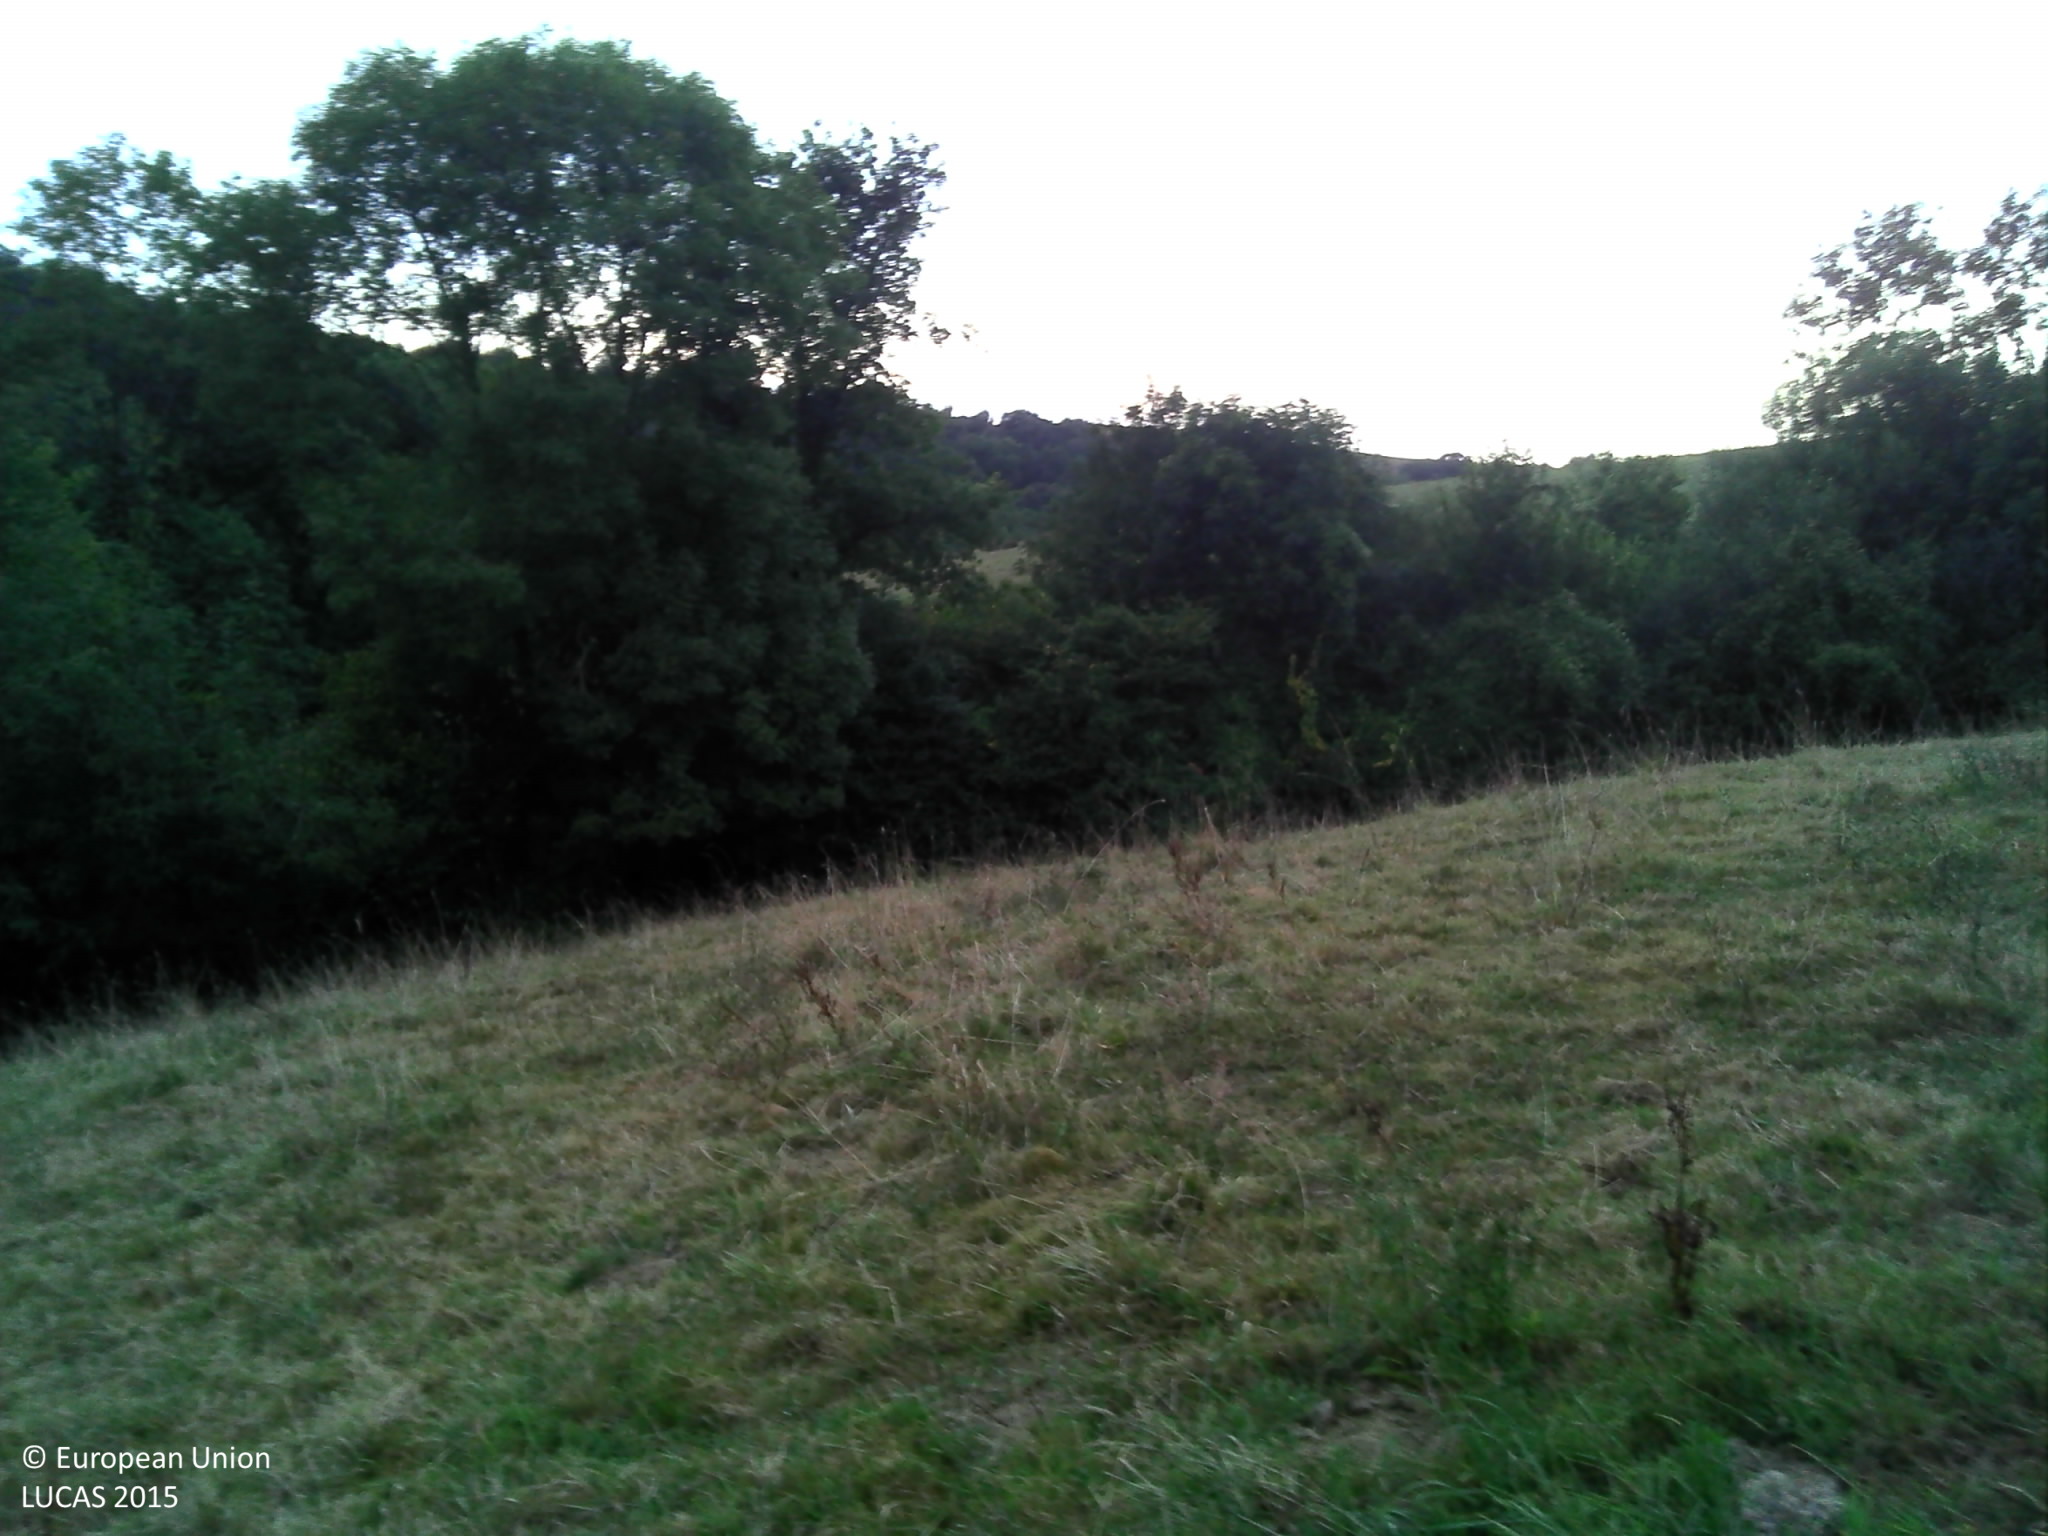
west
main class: Grassland
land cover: Grassland without tree/shrub cover
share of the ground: > 75 %
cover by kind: herbaceous plants 100 %
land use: Agriculture (excluding fallow land and kitchen gardens)
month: August
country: FR
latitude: 43.3951
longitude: -1.2128
